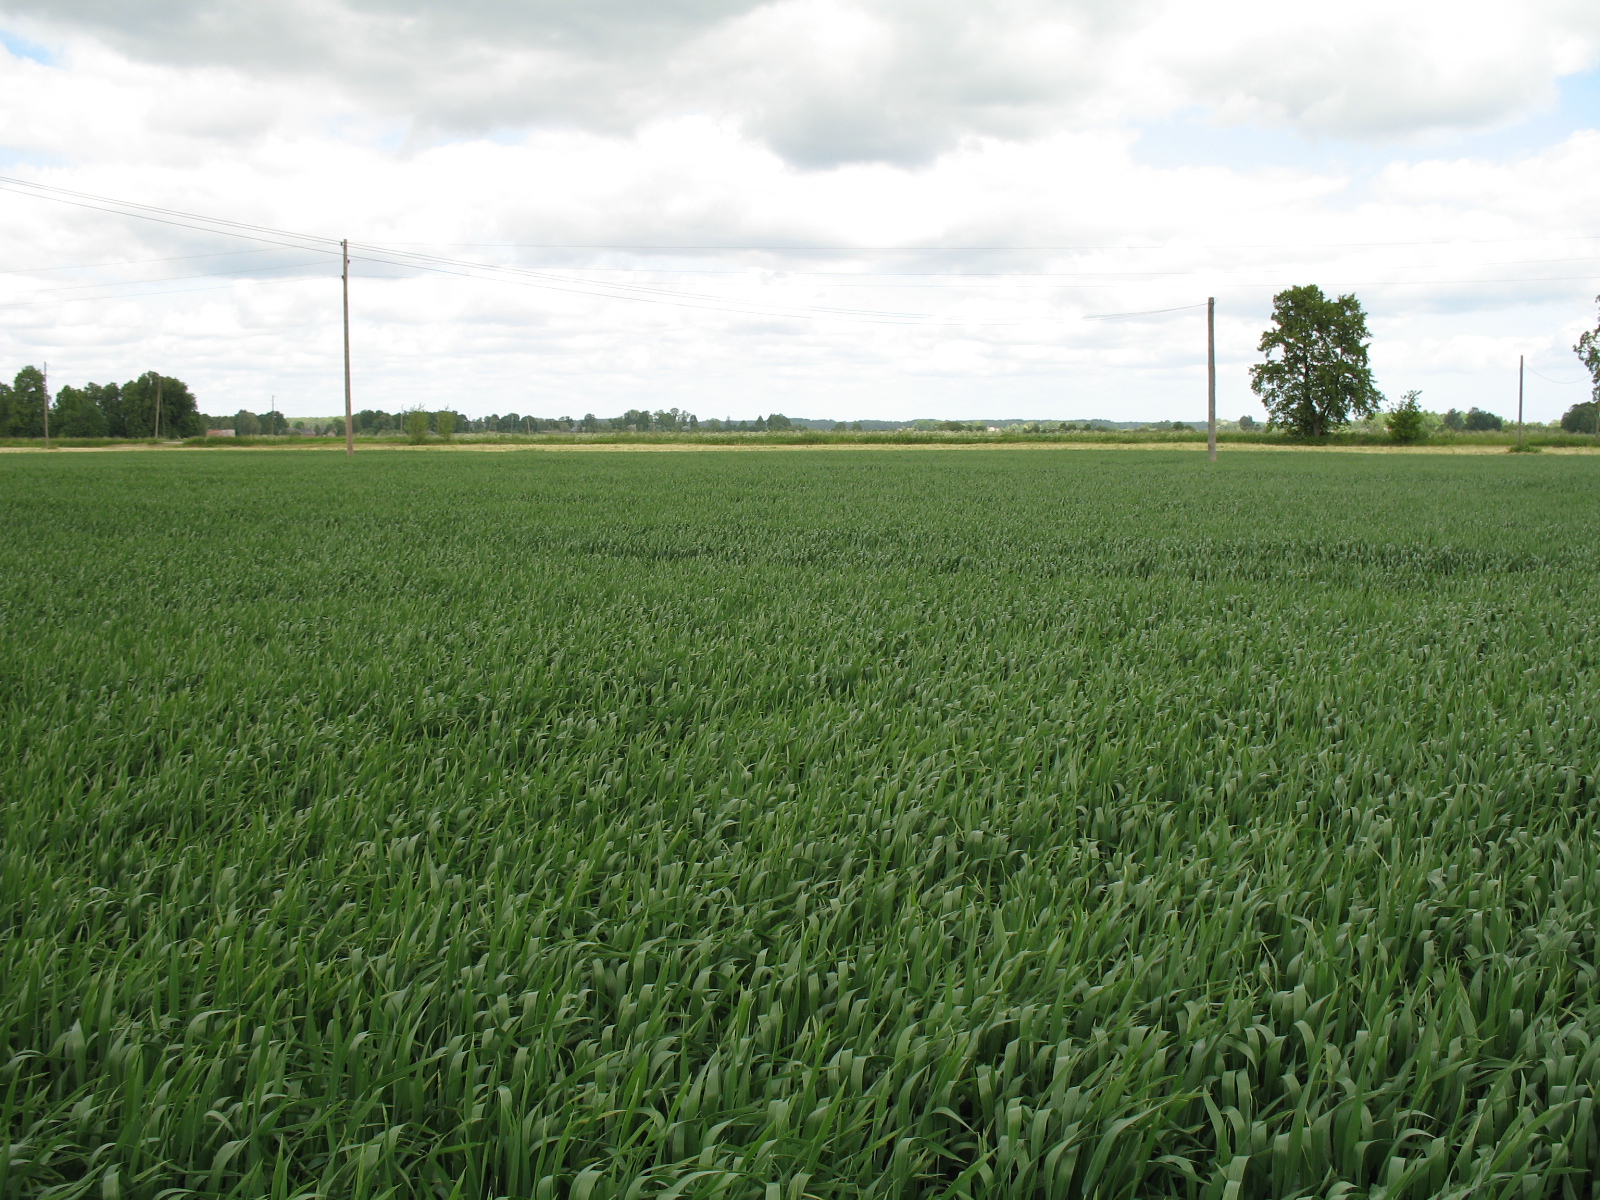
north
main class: Cropland
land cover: Common wheat
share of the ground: > 75 %
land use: Agriculture (excluding fallow land and kitchen gardens)
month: June
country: LV
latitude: 56.6956
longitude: 23.4804
